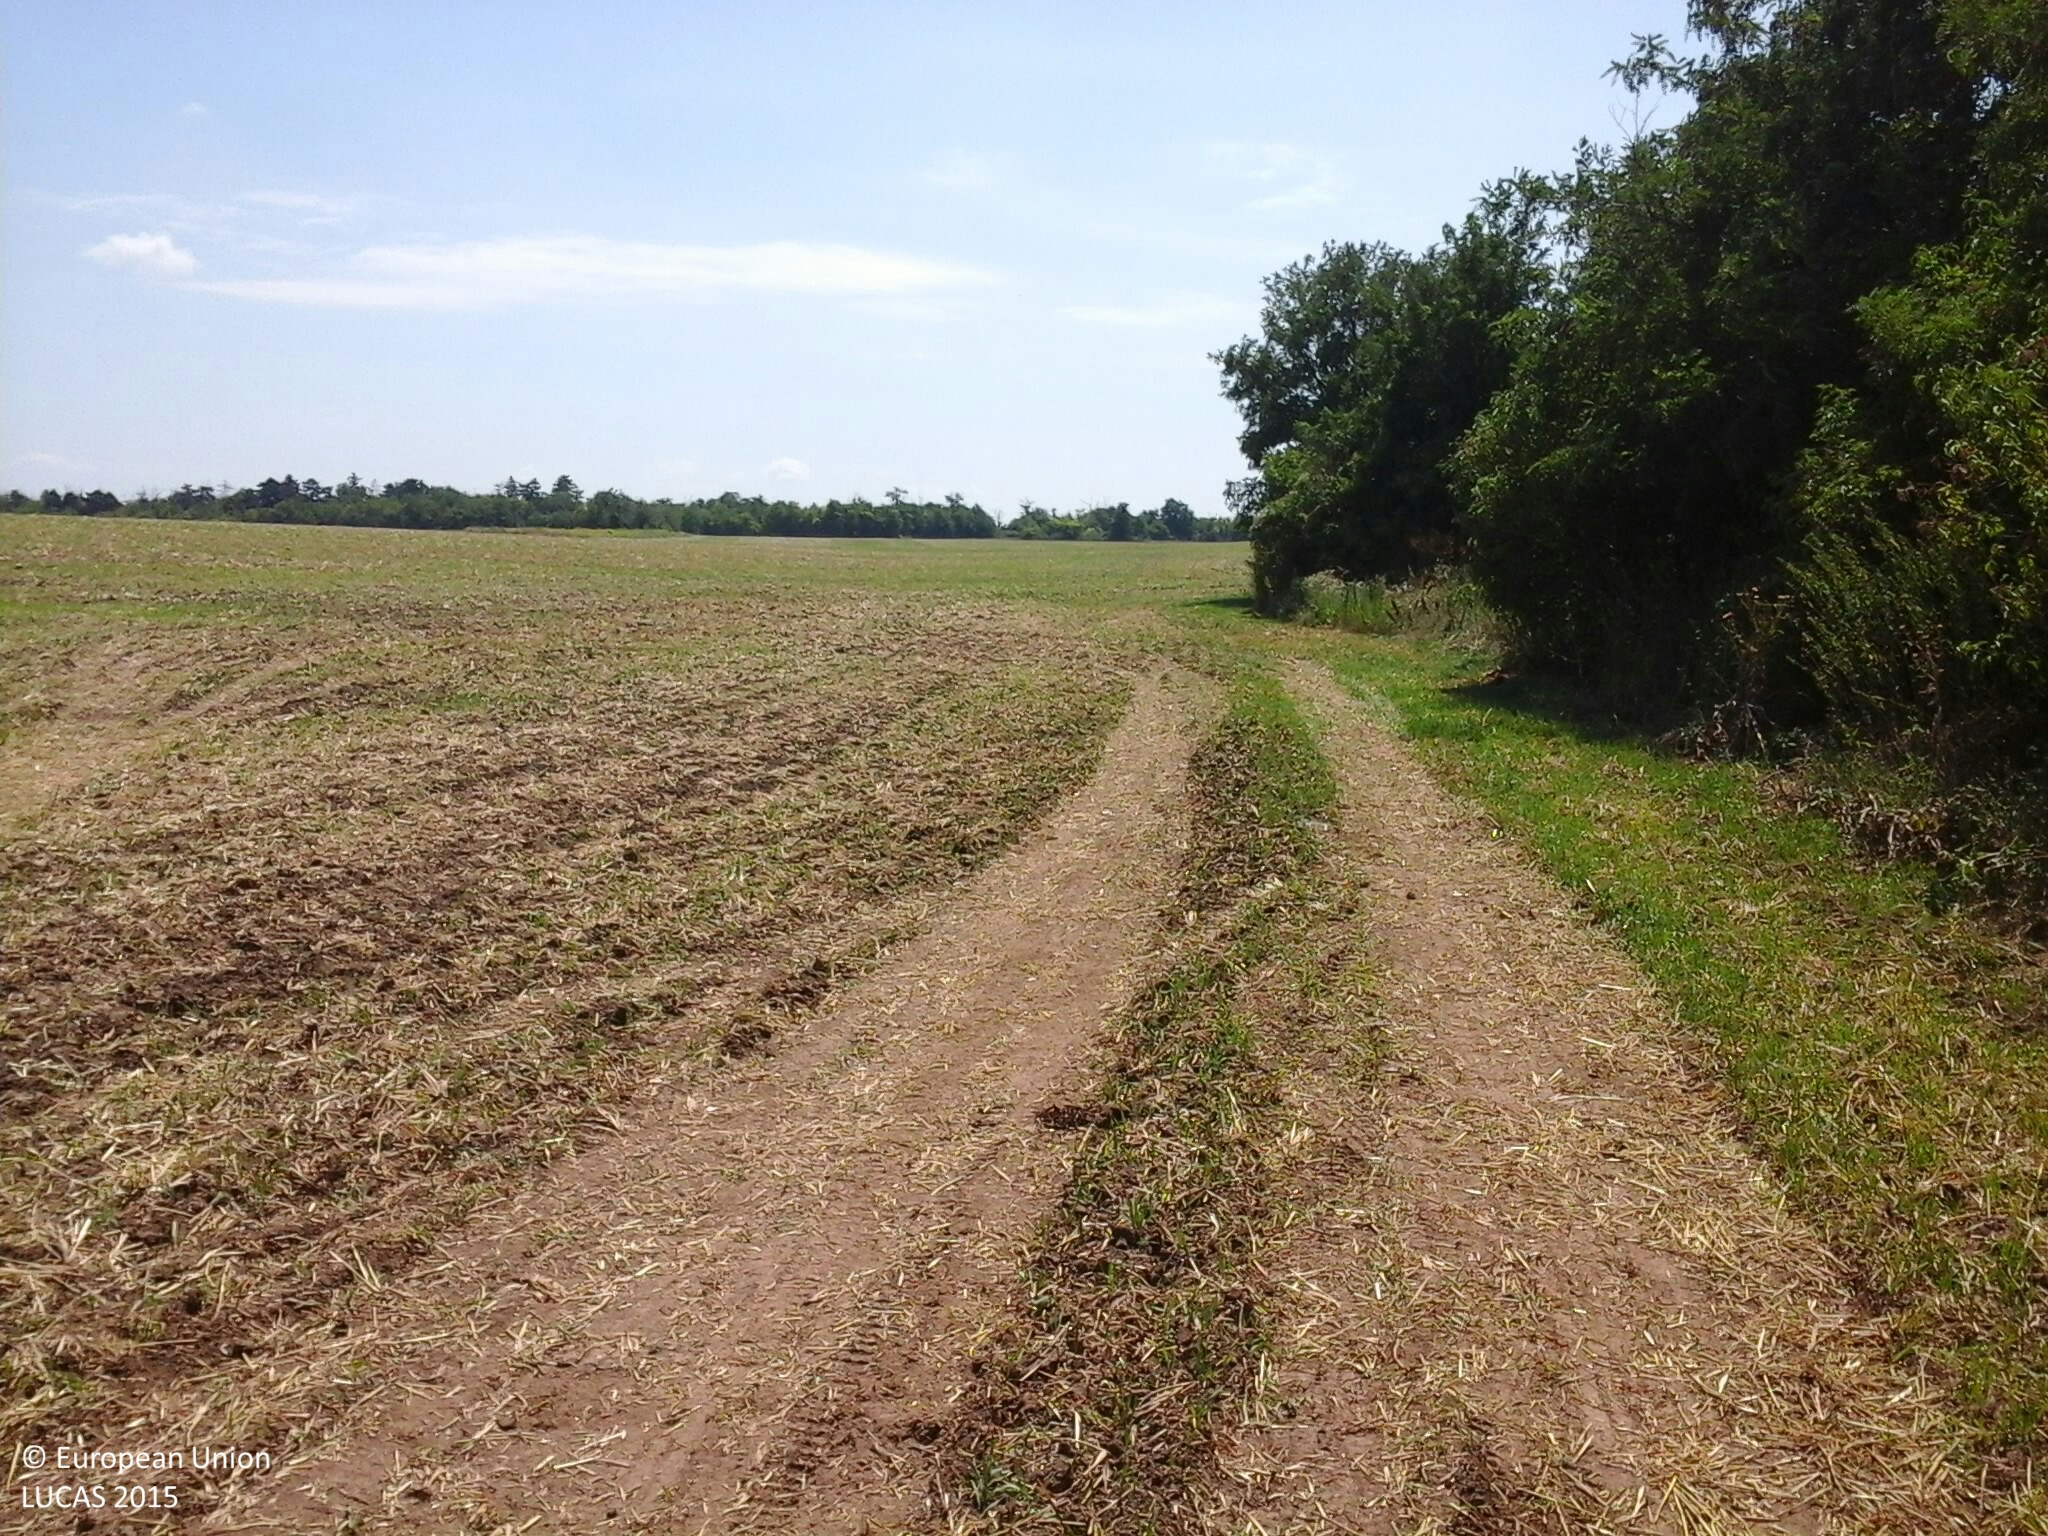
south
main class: Cropland
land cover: Common wheat
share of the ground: > 75 %
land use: Agriculture (excluding fallow land and kitchen gardens)
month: August
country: HU
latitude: 46.8617
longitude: 18.0499
